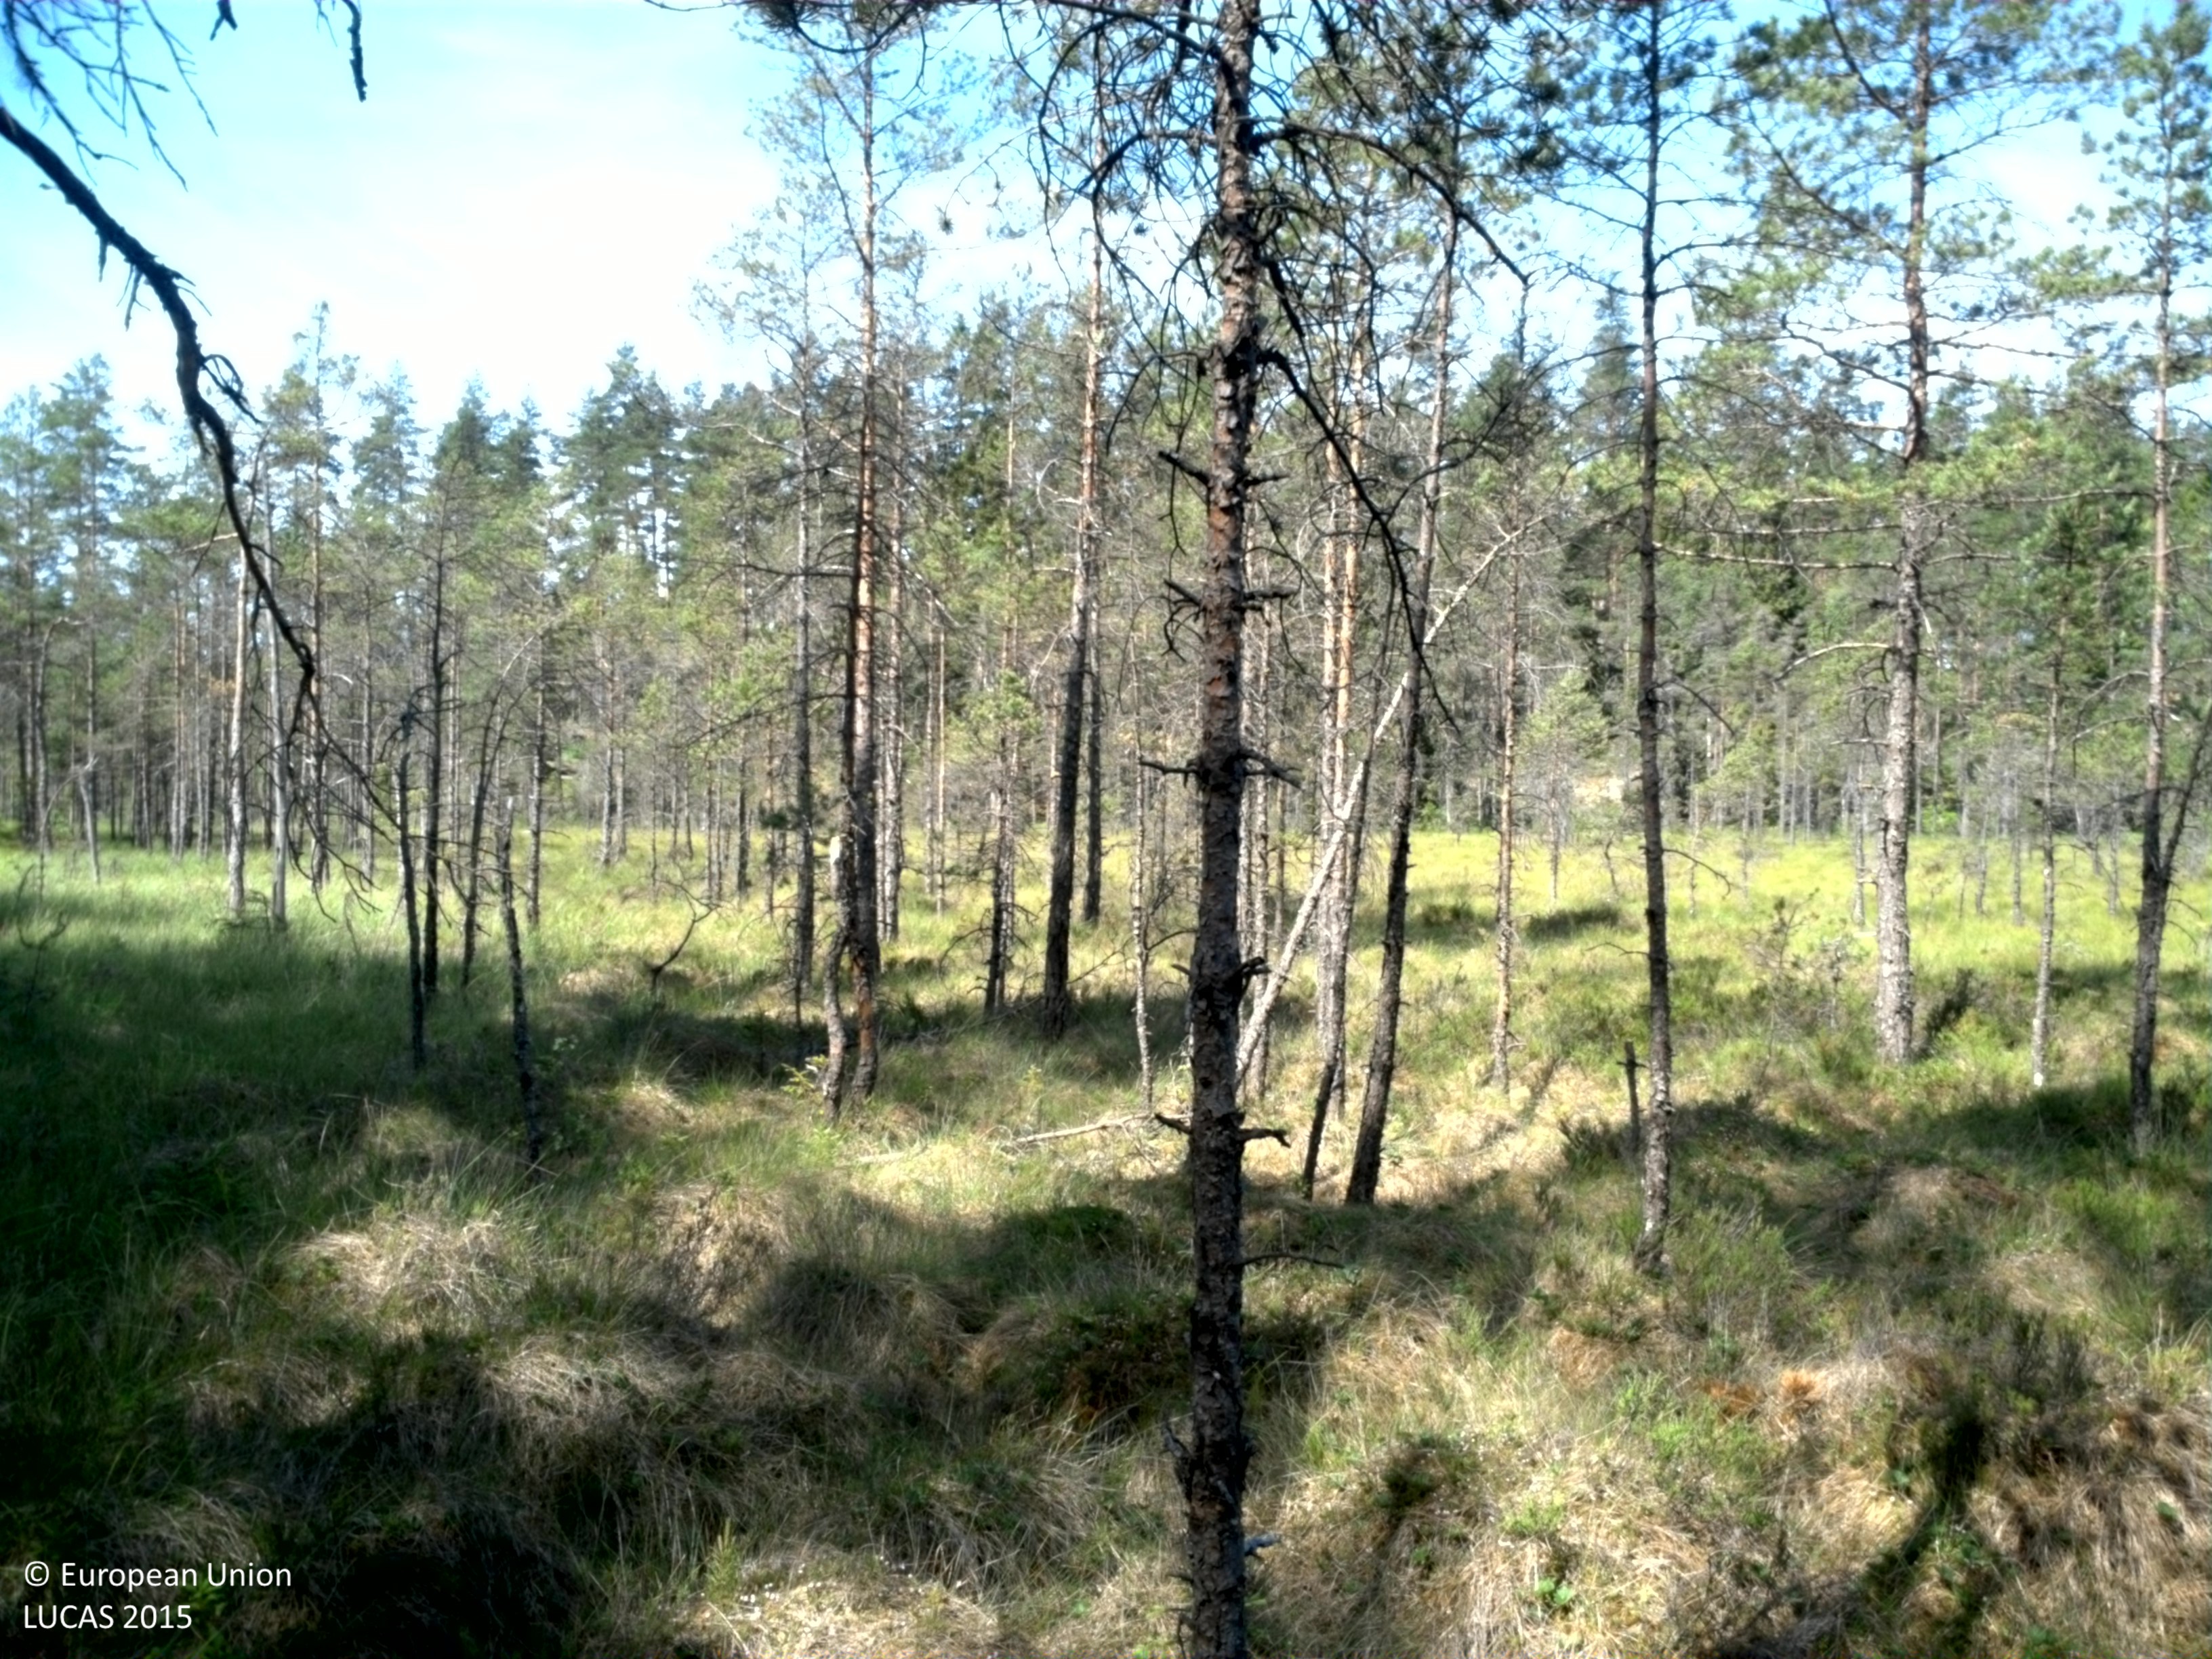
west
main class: Woodland
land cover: Pine dominated coniferous woodland
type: boreal forest
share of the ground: 10 - 25 %
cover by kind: lichens and mosses 45 %, coniferous forest trees 20 %, herbaceous plants 20 %, shrubs 10 %, broadleaved forest trees 5 %
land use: Forestry
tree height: > 5 m
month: July
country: SE
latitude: 57.6238
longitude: 13.8631
